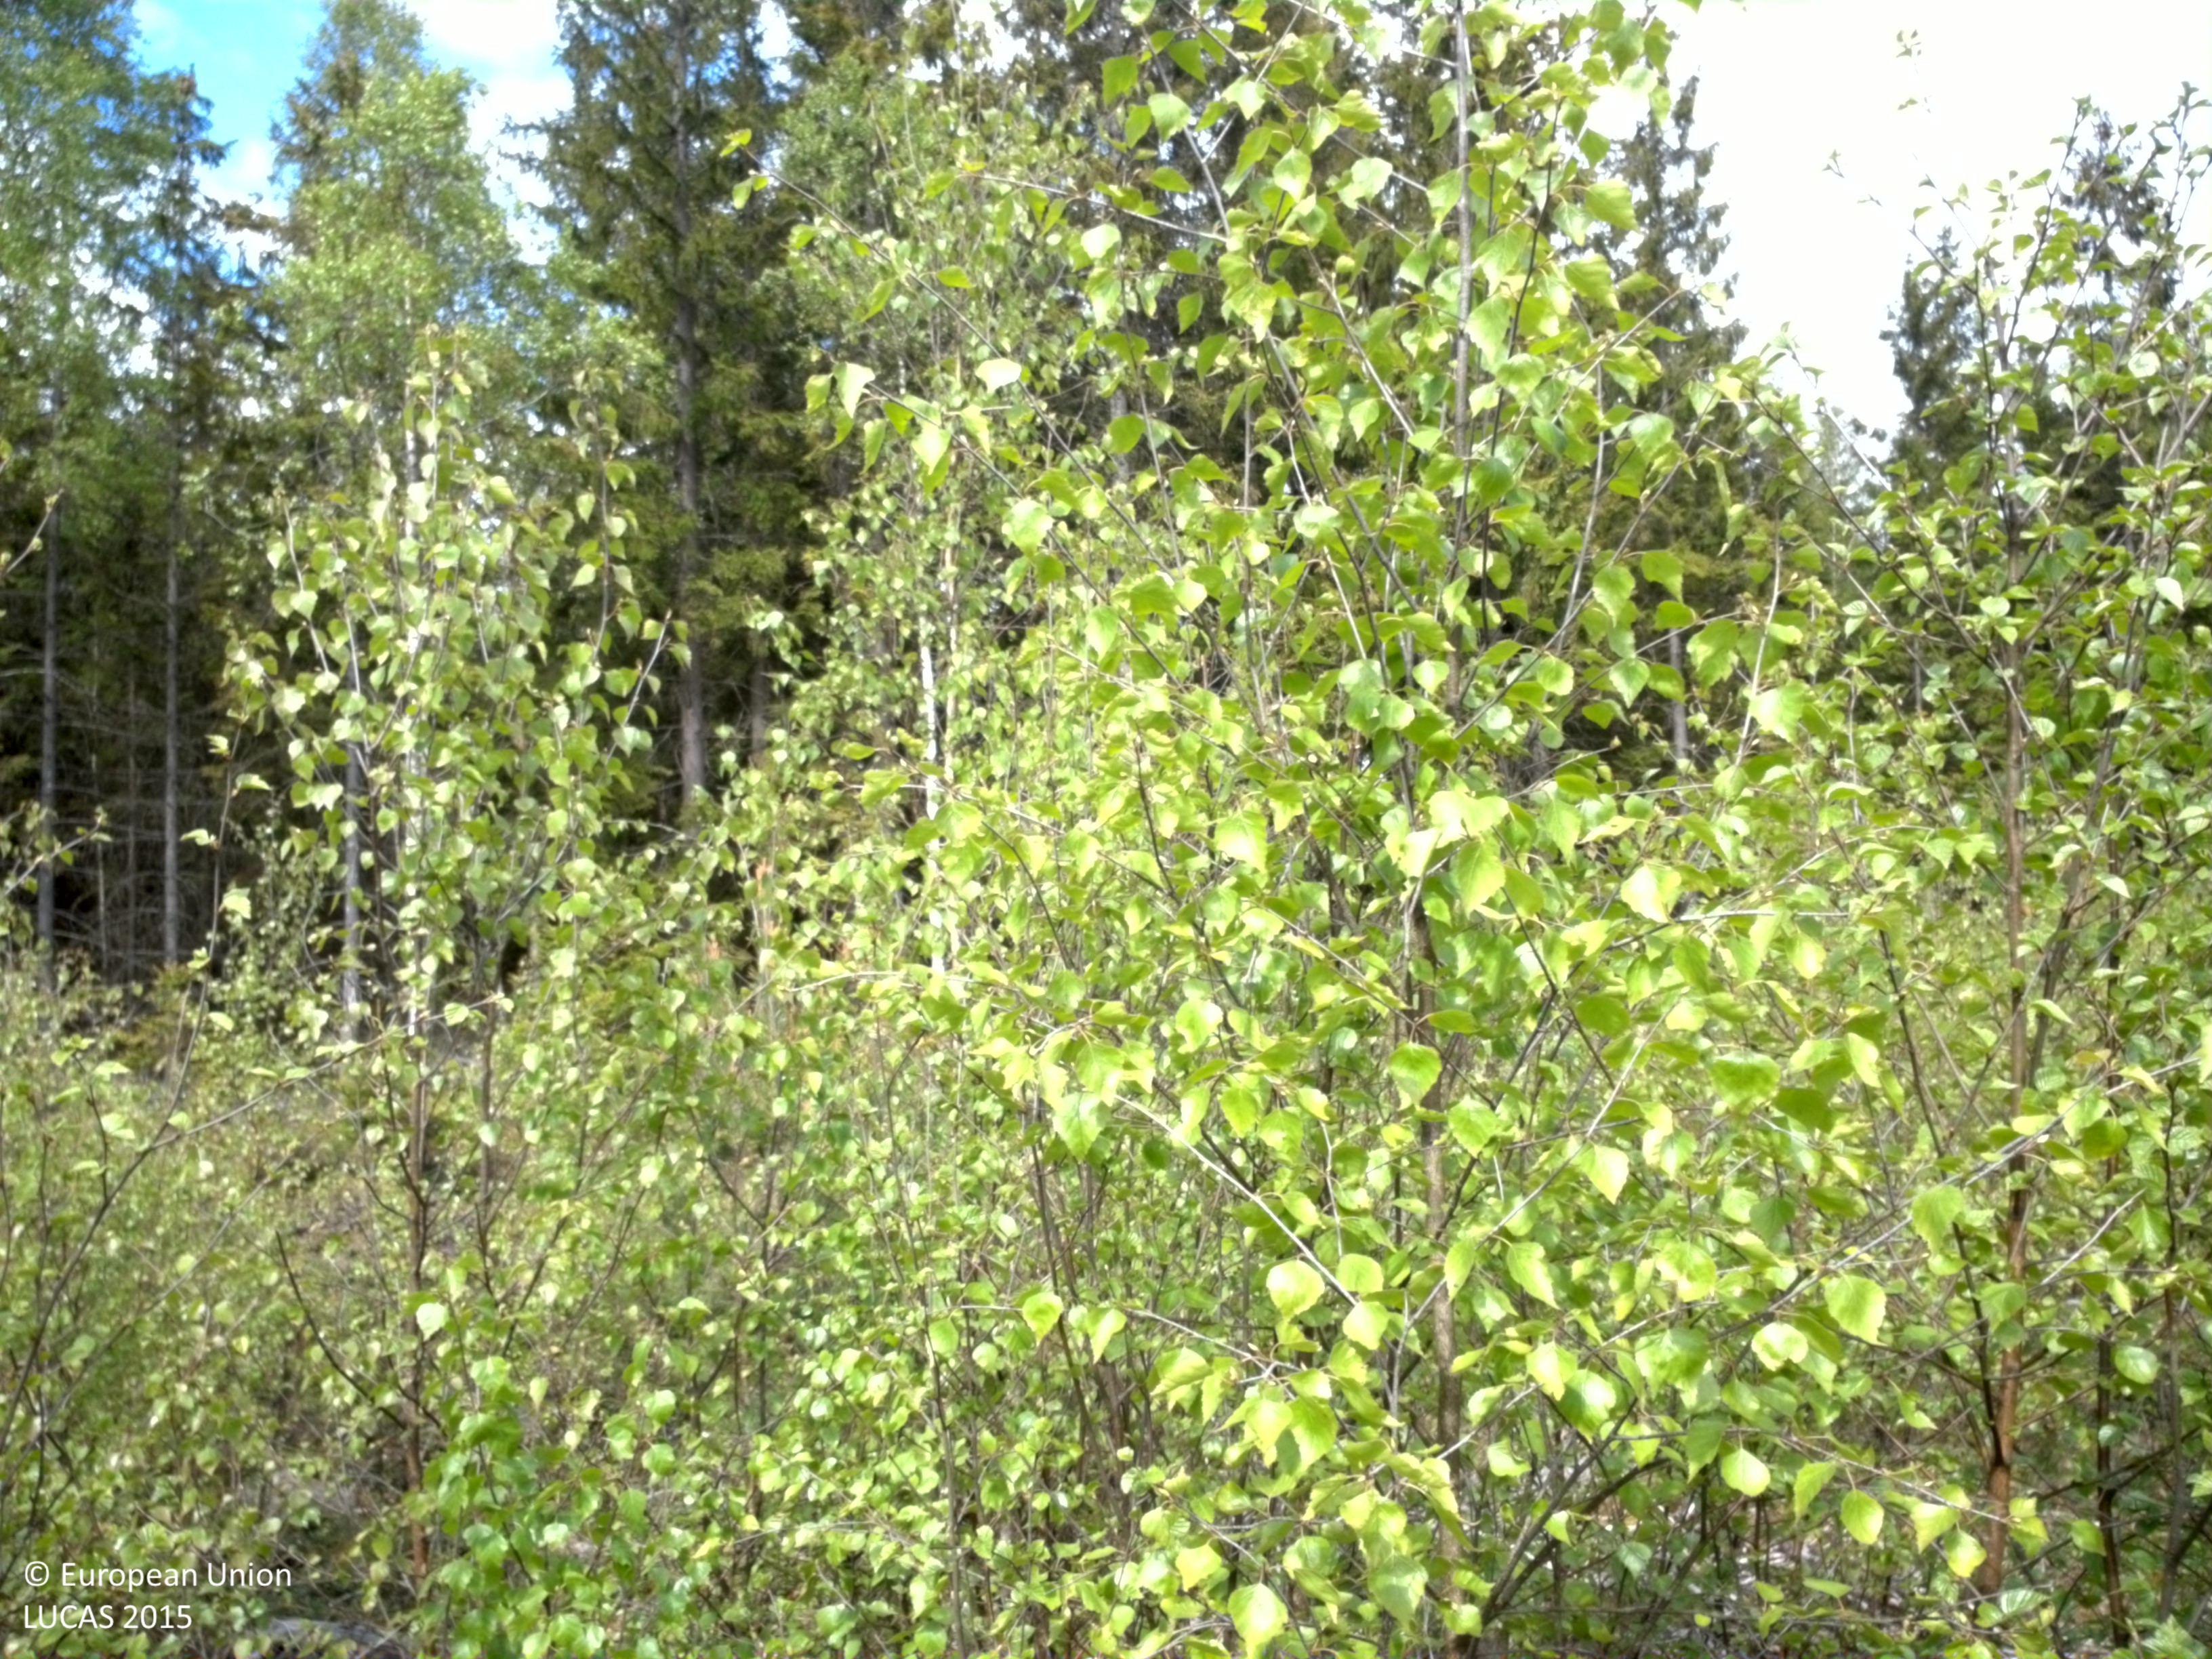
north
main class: Woodland
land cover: Broadleaved woodland
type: boreal forest
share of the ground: > 75 %
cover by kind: broadleaved forest trees 80 %, coniferous forest trees 10 %, lichens and mosses 10 %
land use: Forestry
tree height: < 5 m
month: May
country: SE
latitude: 56.6868
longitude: 14.4540
